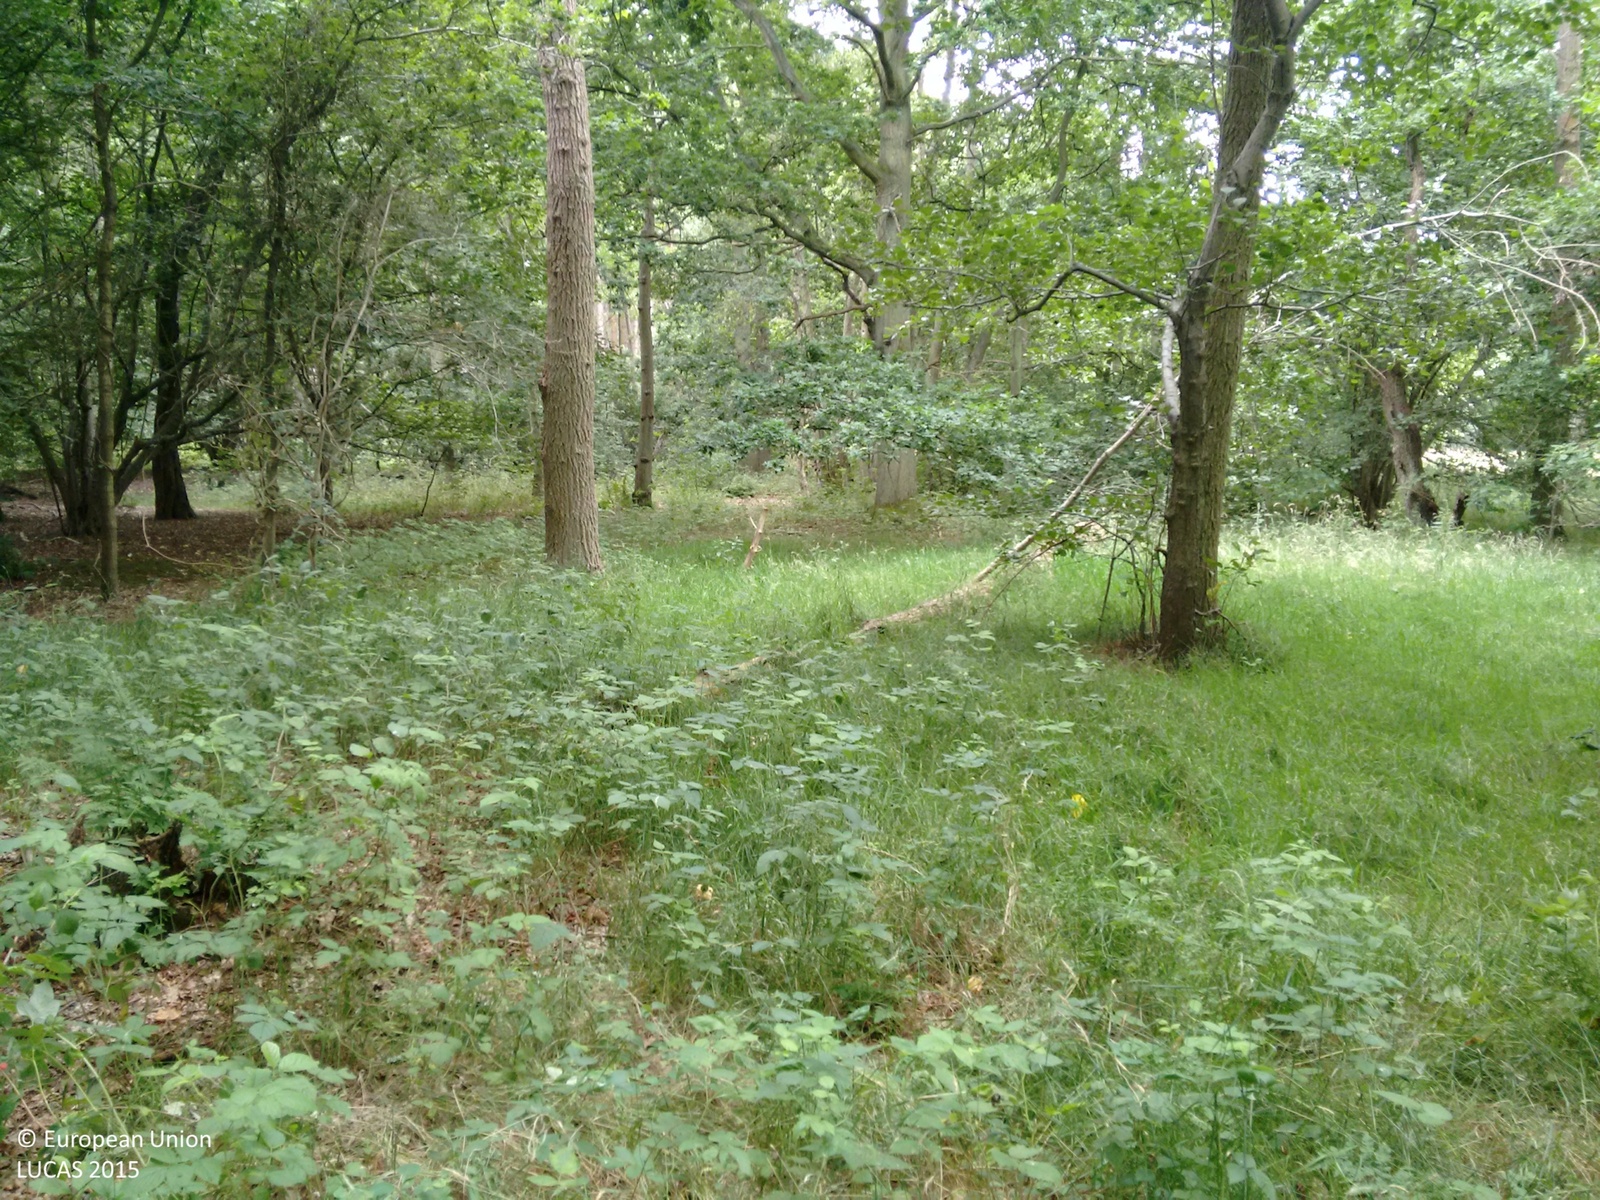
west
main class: Woodland
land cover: Broadleaved woodland
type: mesophytic deciduous forest
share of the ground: > 75 %
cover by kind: broadleaved forest trees 100 %
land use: Amenities, museums, leisure
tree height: > 5 m
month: August
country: GB
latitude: 52.3603
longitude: 0.5307
